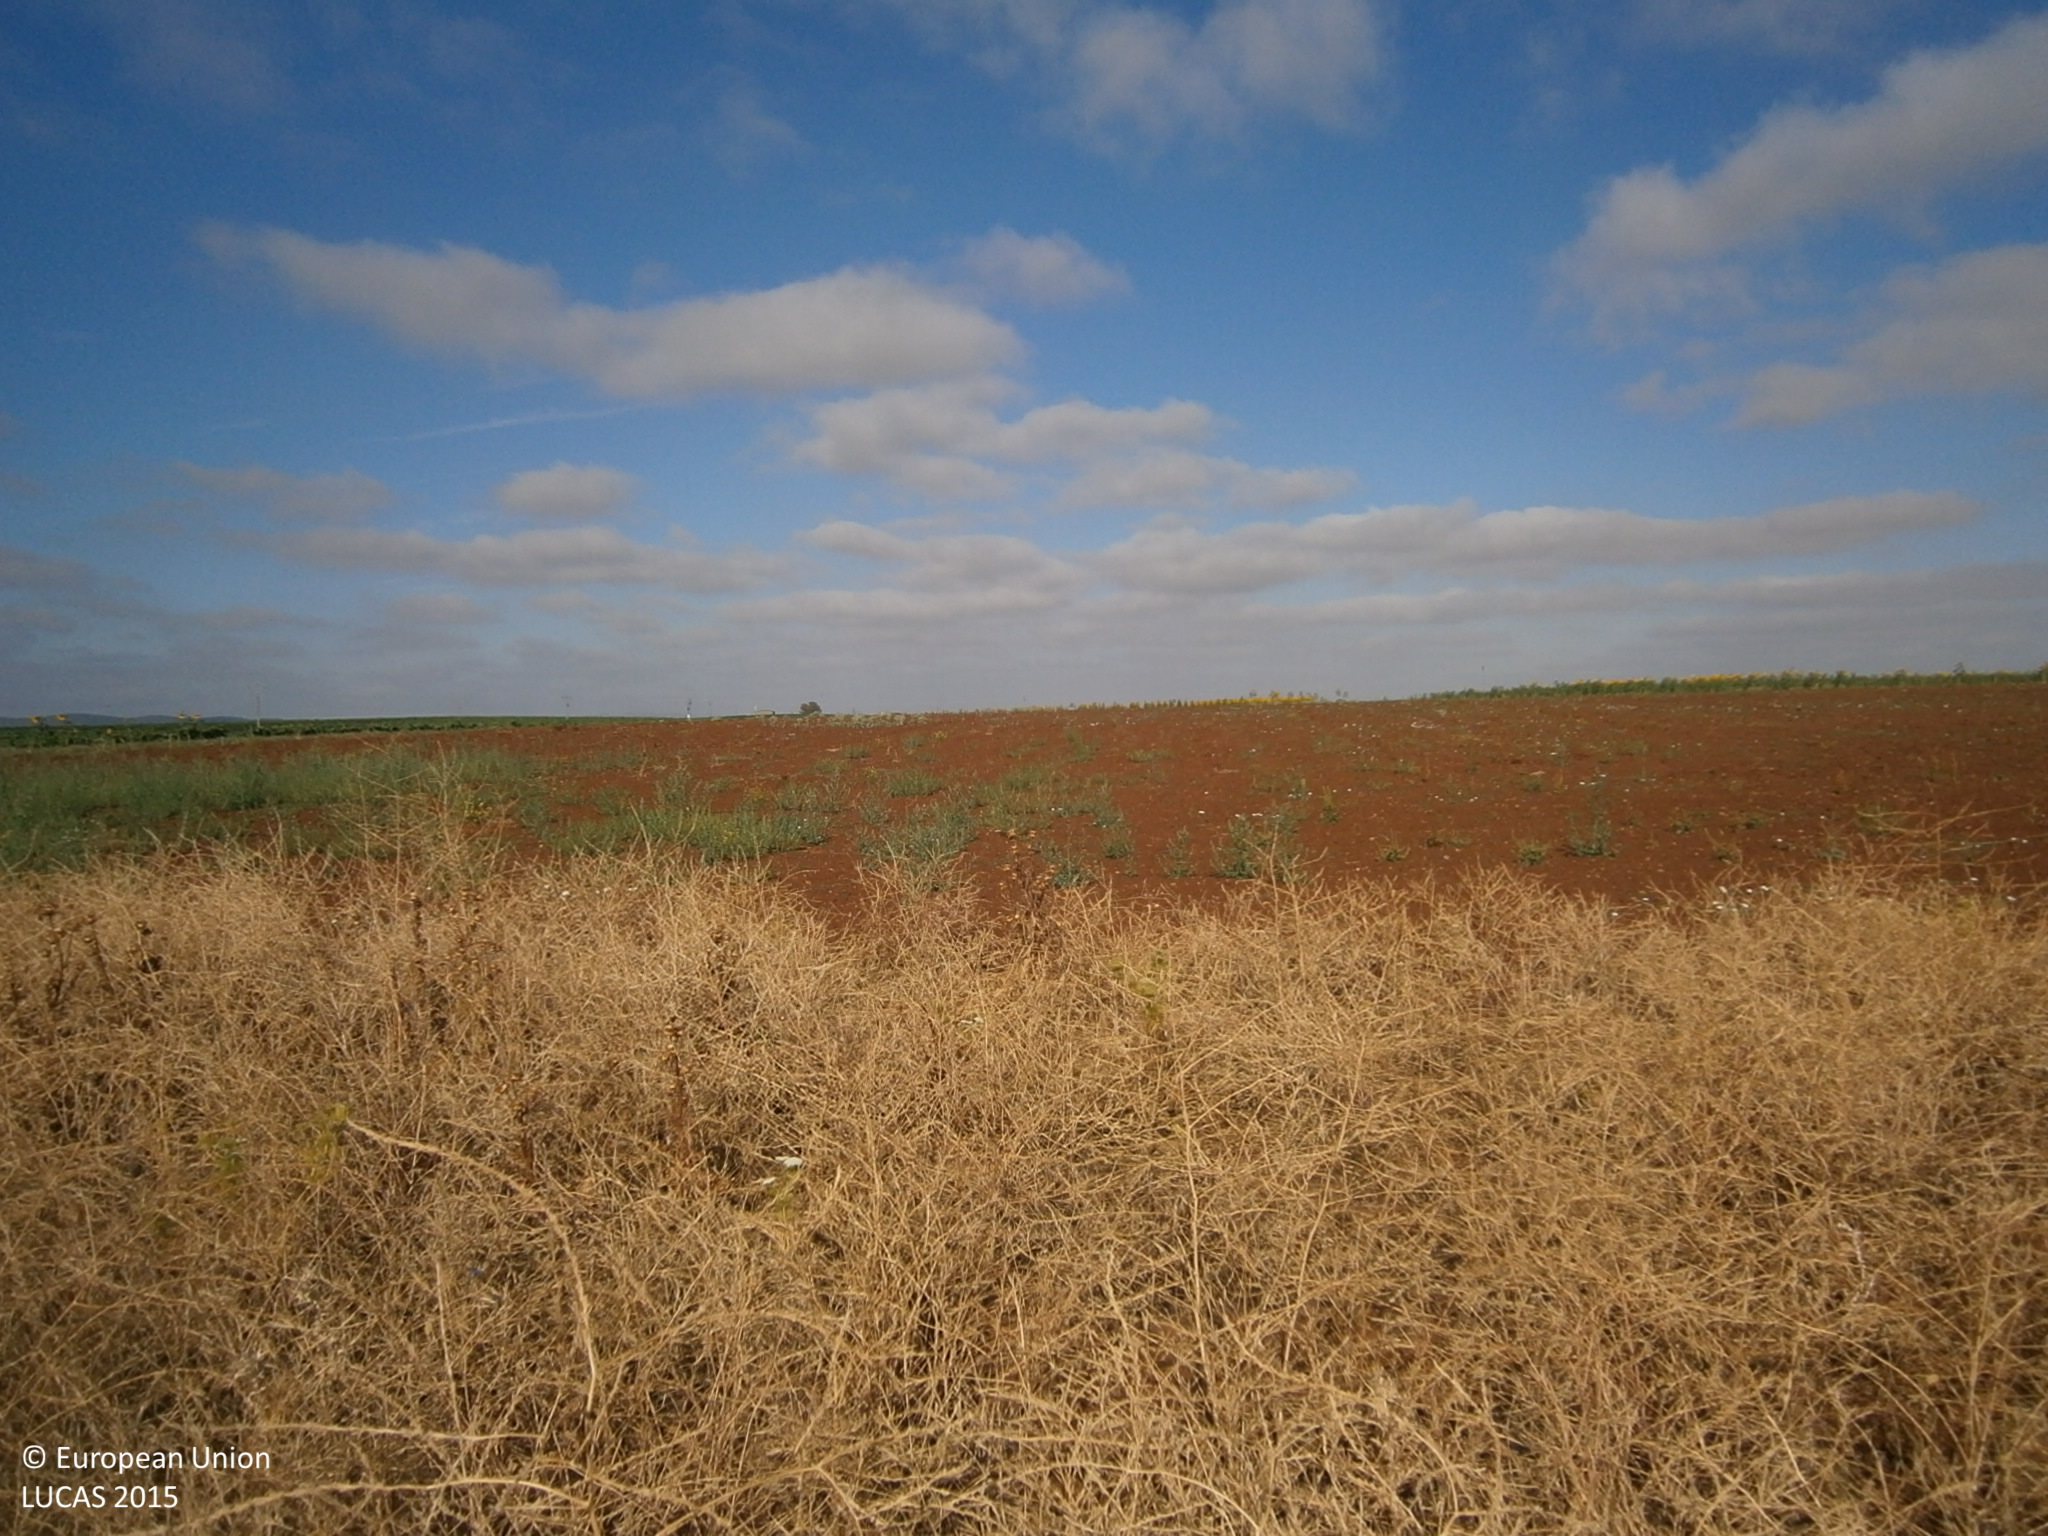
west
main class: Grassland
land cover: Spontaneously vegetated surfaces
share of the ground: > 75 %
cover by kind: herbaceous plants 95 %, unconsolidated bare surface 5 %
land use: Fallow land
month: June
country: ES
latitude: 38.7073
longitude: -6.8417
